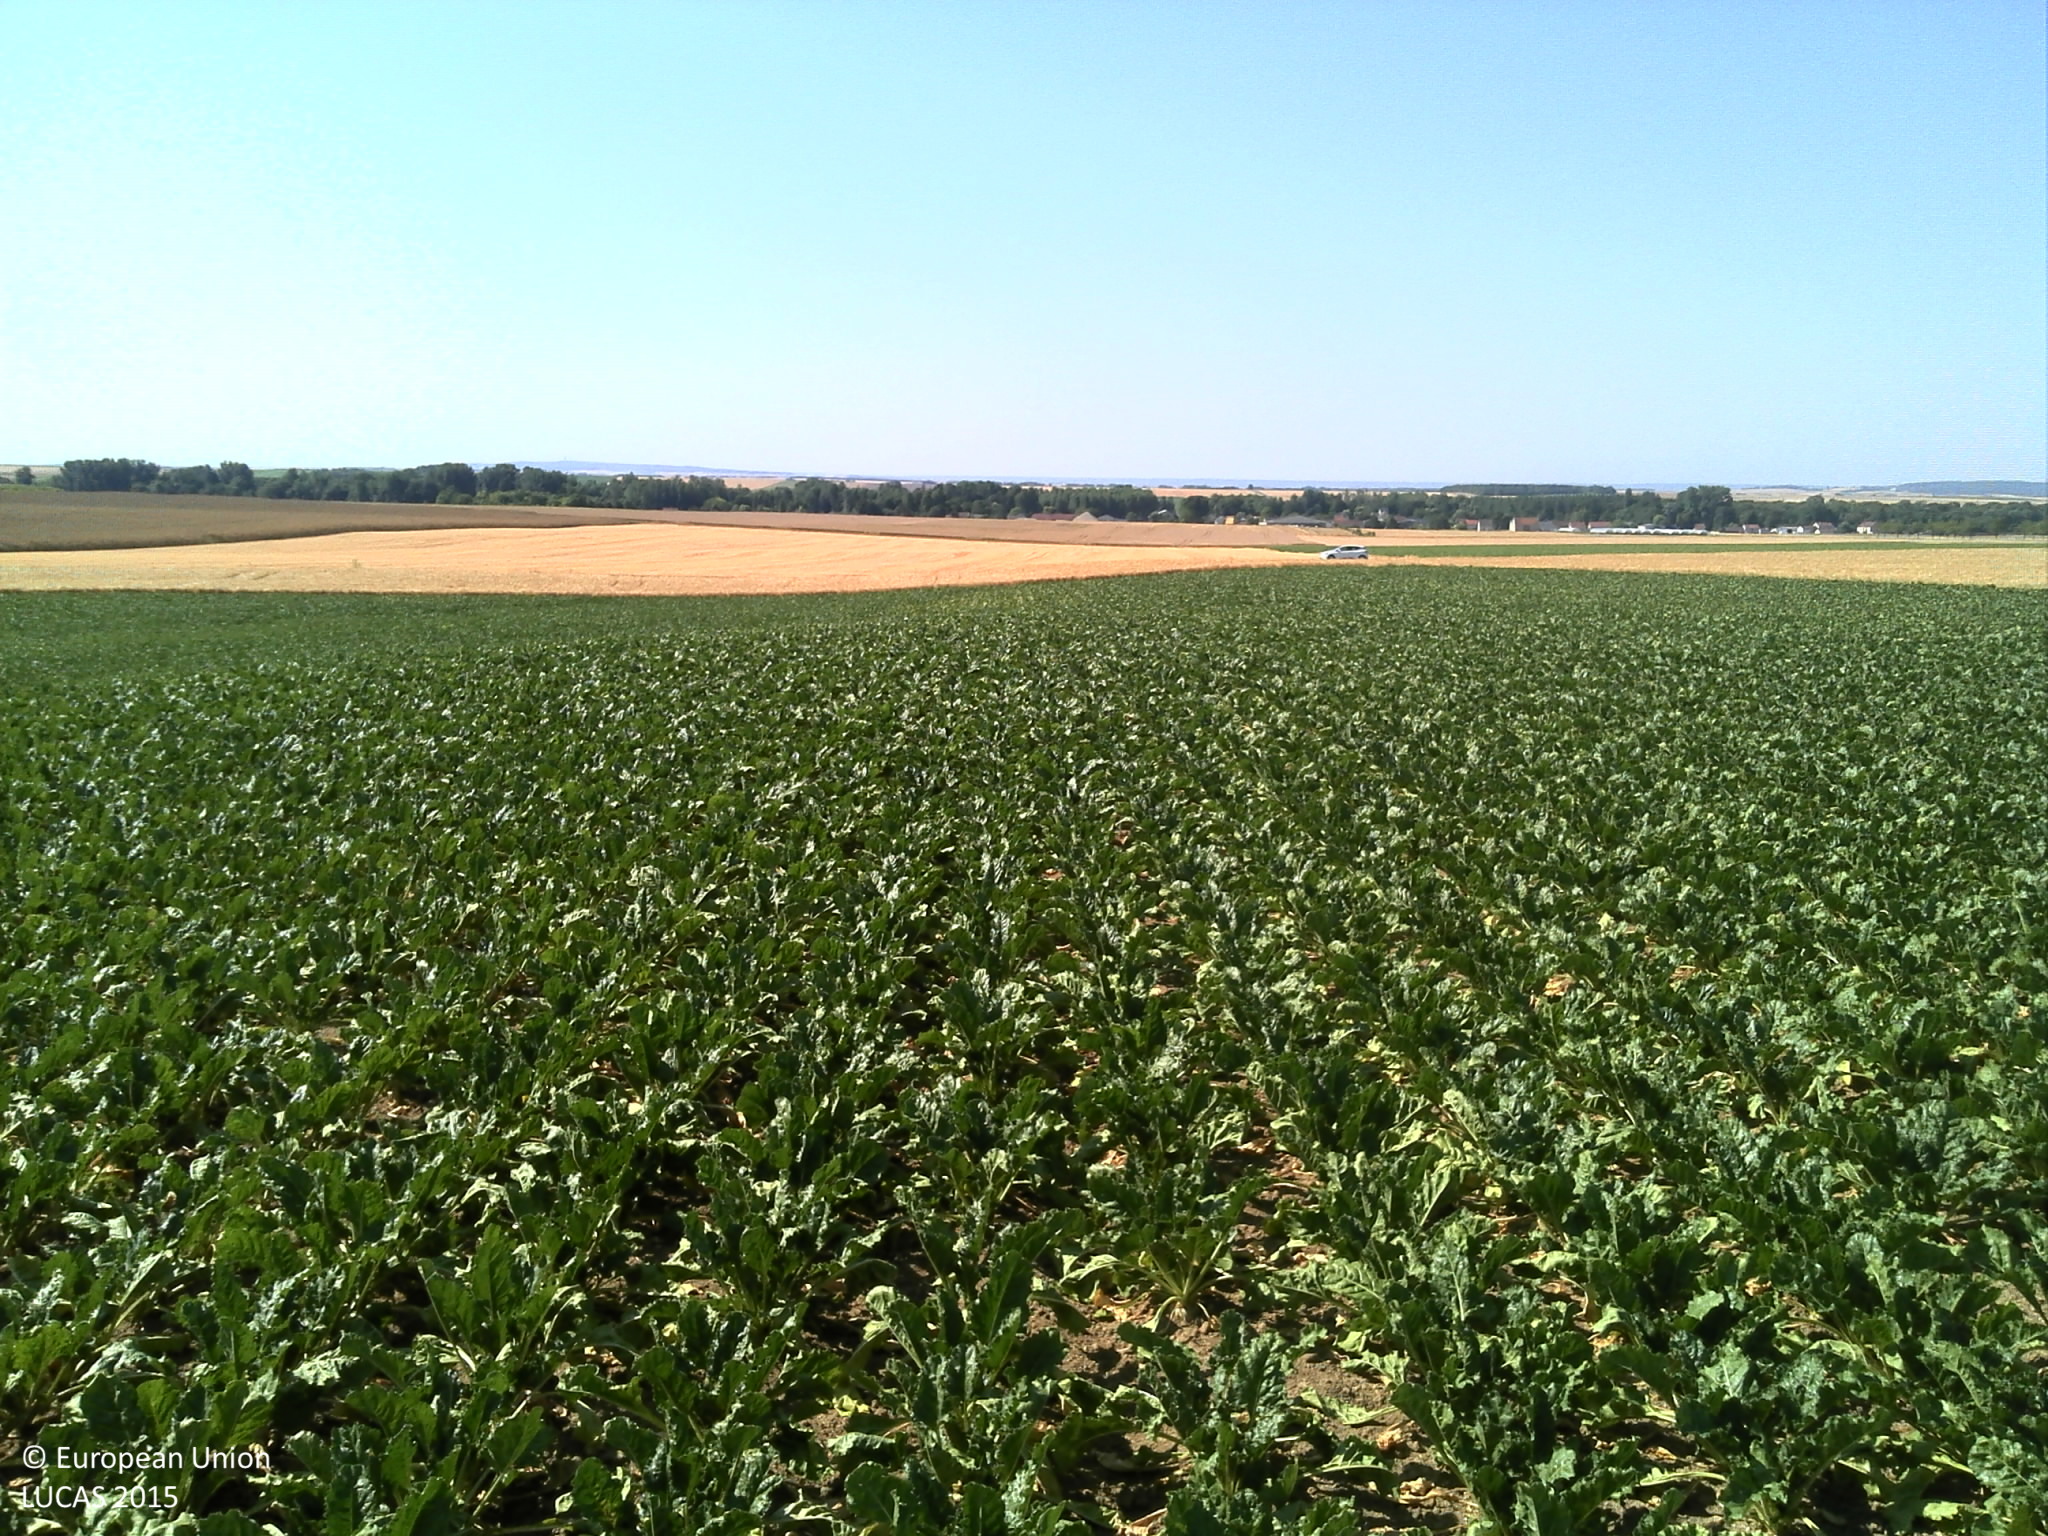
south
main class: Cropland
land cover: Sugar beet
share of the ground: > 75 %
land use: Agriculture (excluding fallow land and kitchen gardens)
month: July
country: FR
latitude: 49.4368
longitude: 4.1067
